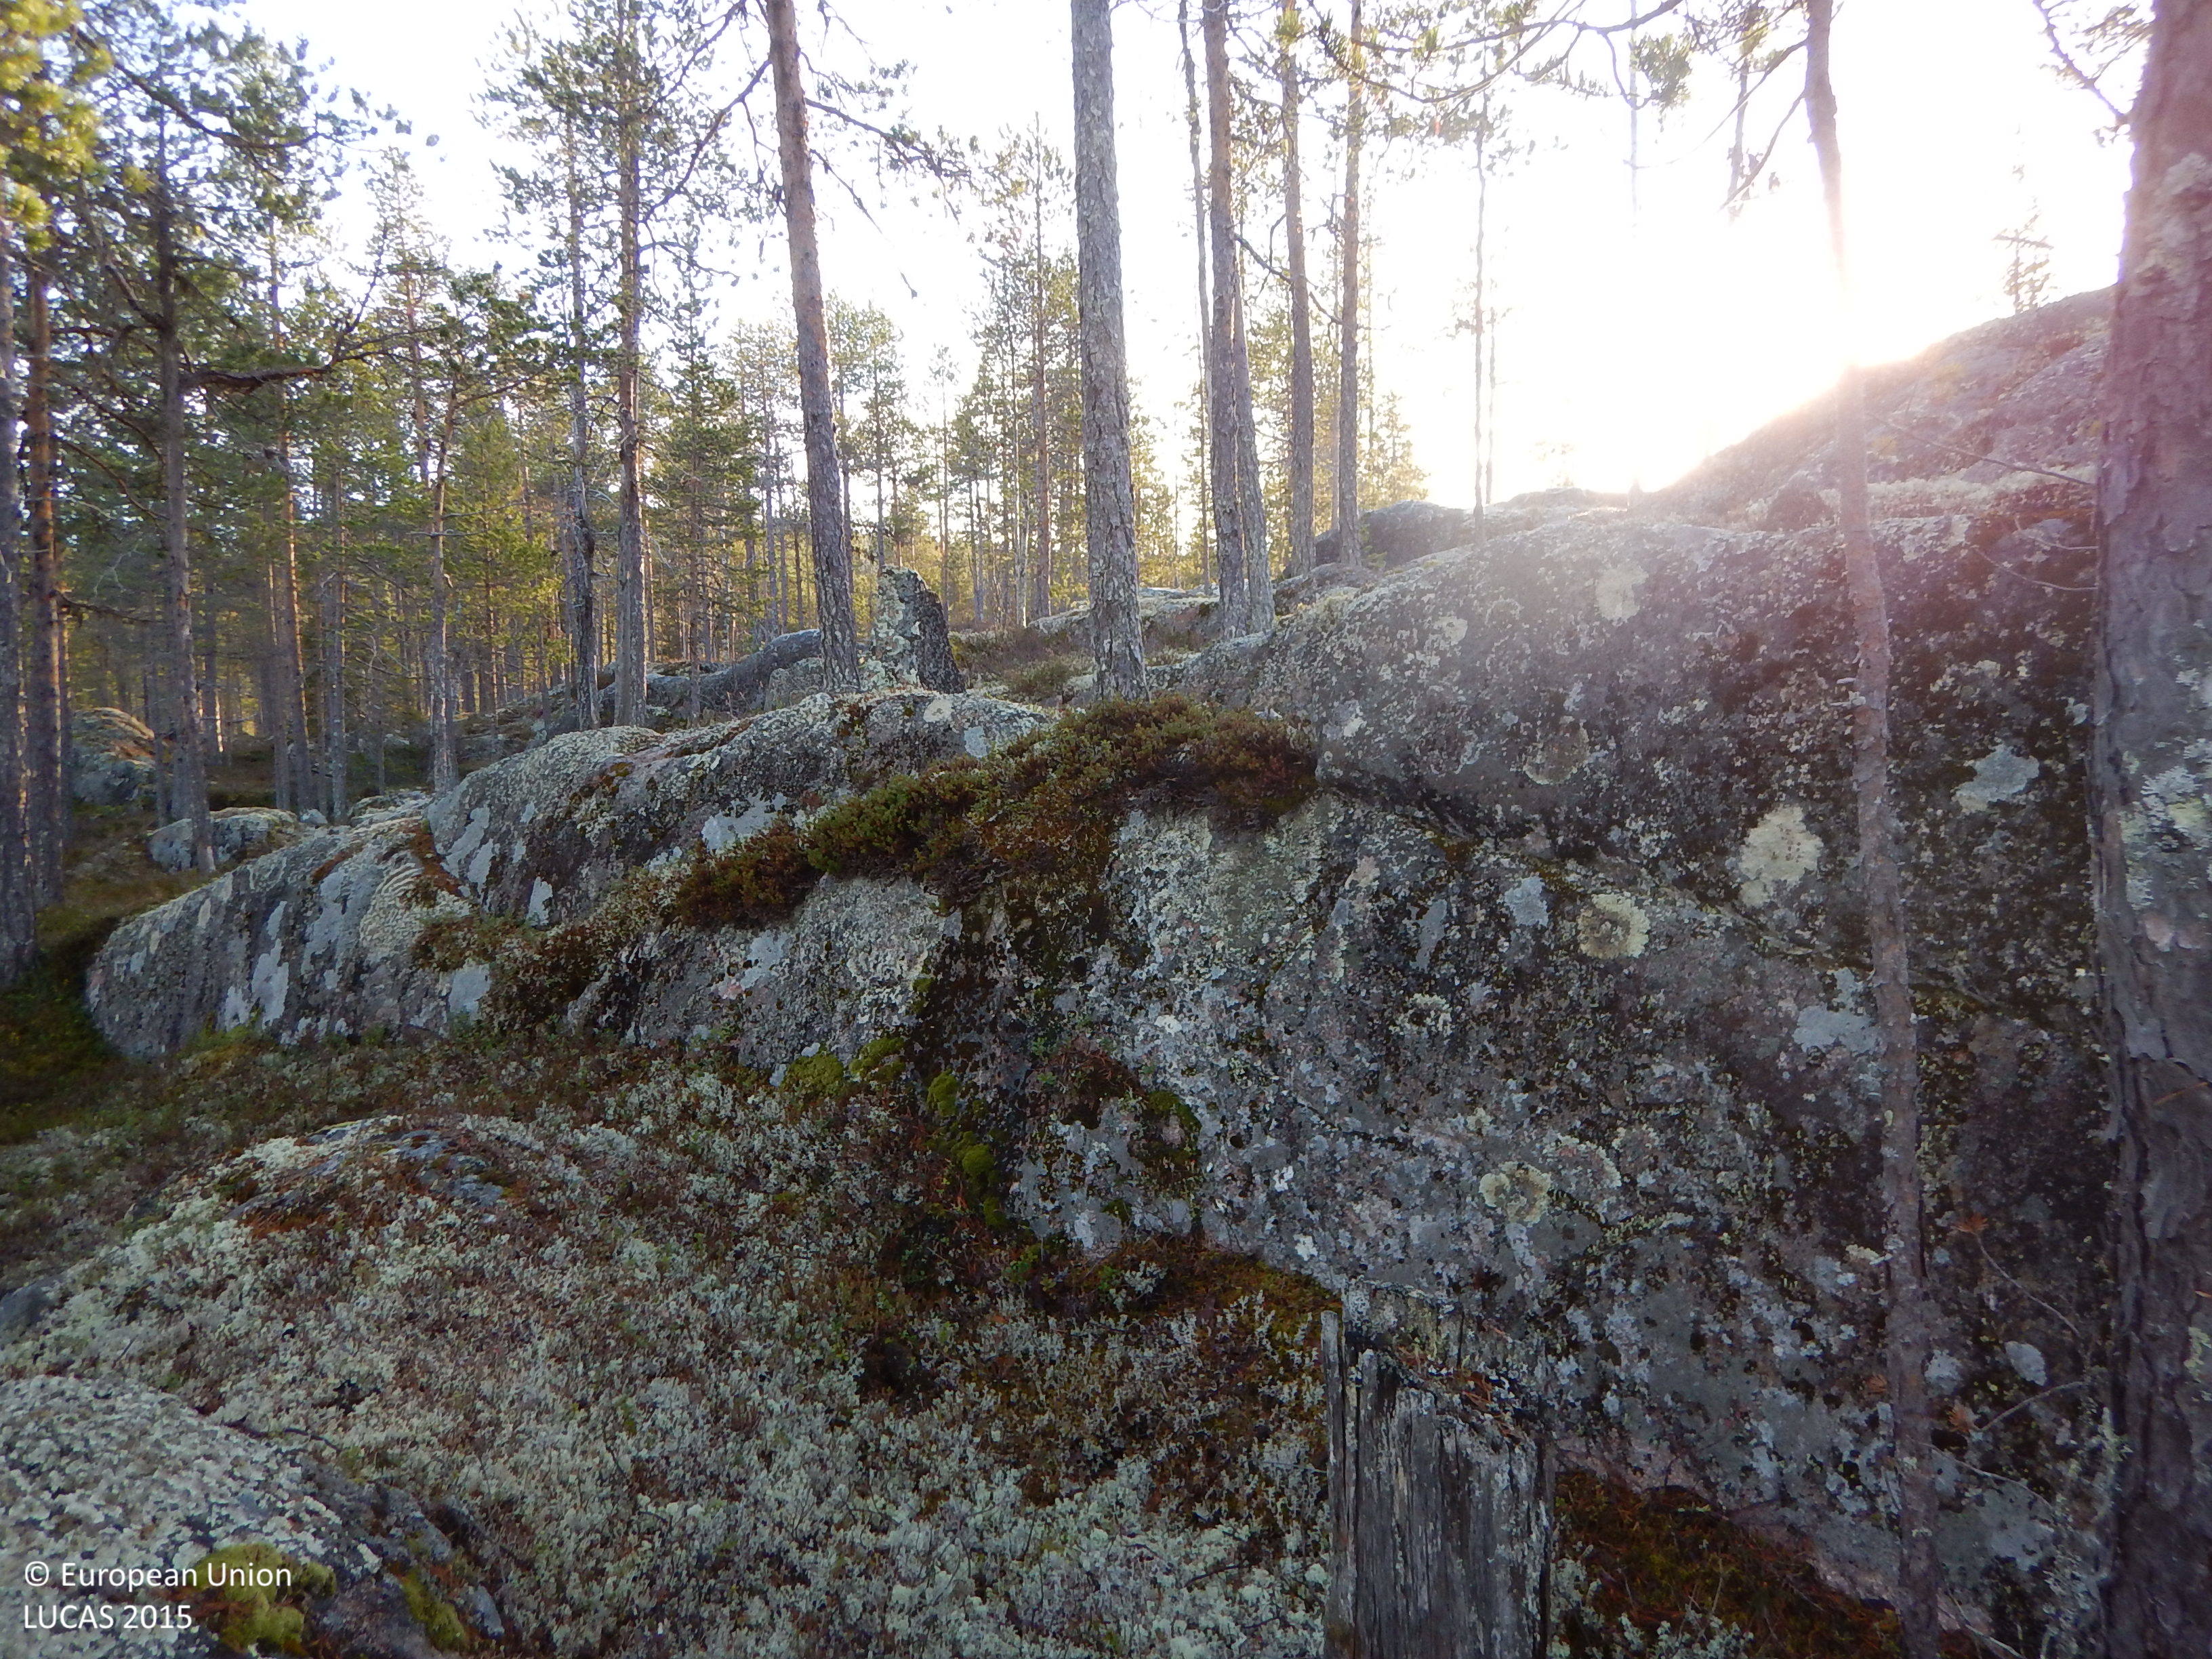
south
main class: Woodland
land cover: Pine dominated coniferous woodland
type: boreal forest
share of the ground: 50 - 75 %
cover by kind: coniferous forest trees 55 %, shrubs 15 %, herbaceous plants 10 %, lichens and mosses 10 %, consolidated bare surface 10 %
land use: Forestry
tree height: > 5 m
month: October
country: SE
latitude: 65.2713
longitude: 20.2300
